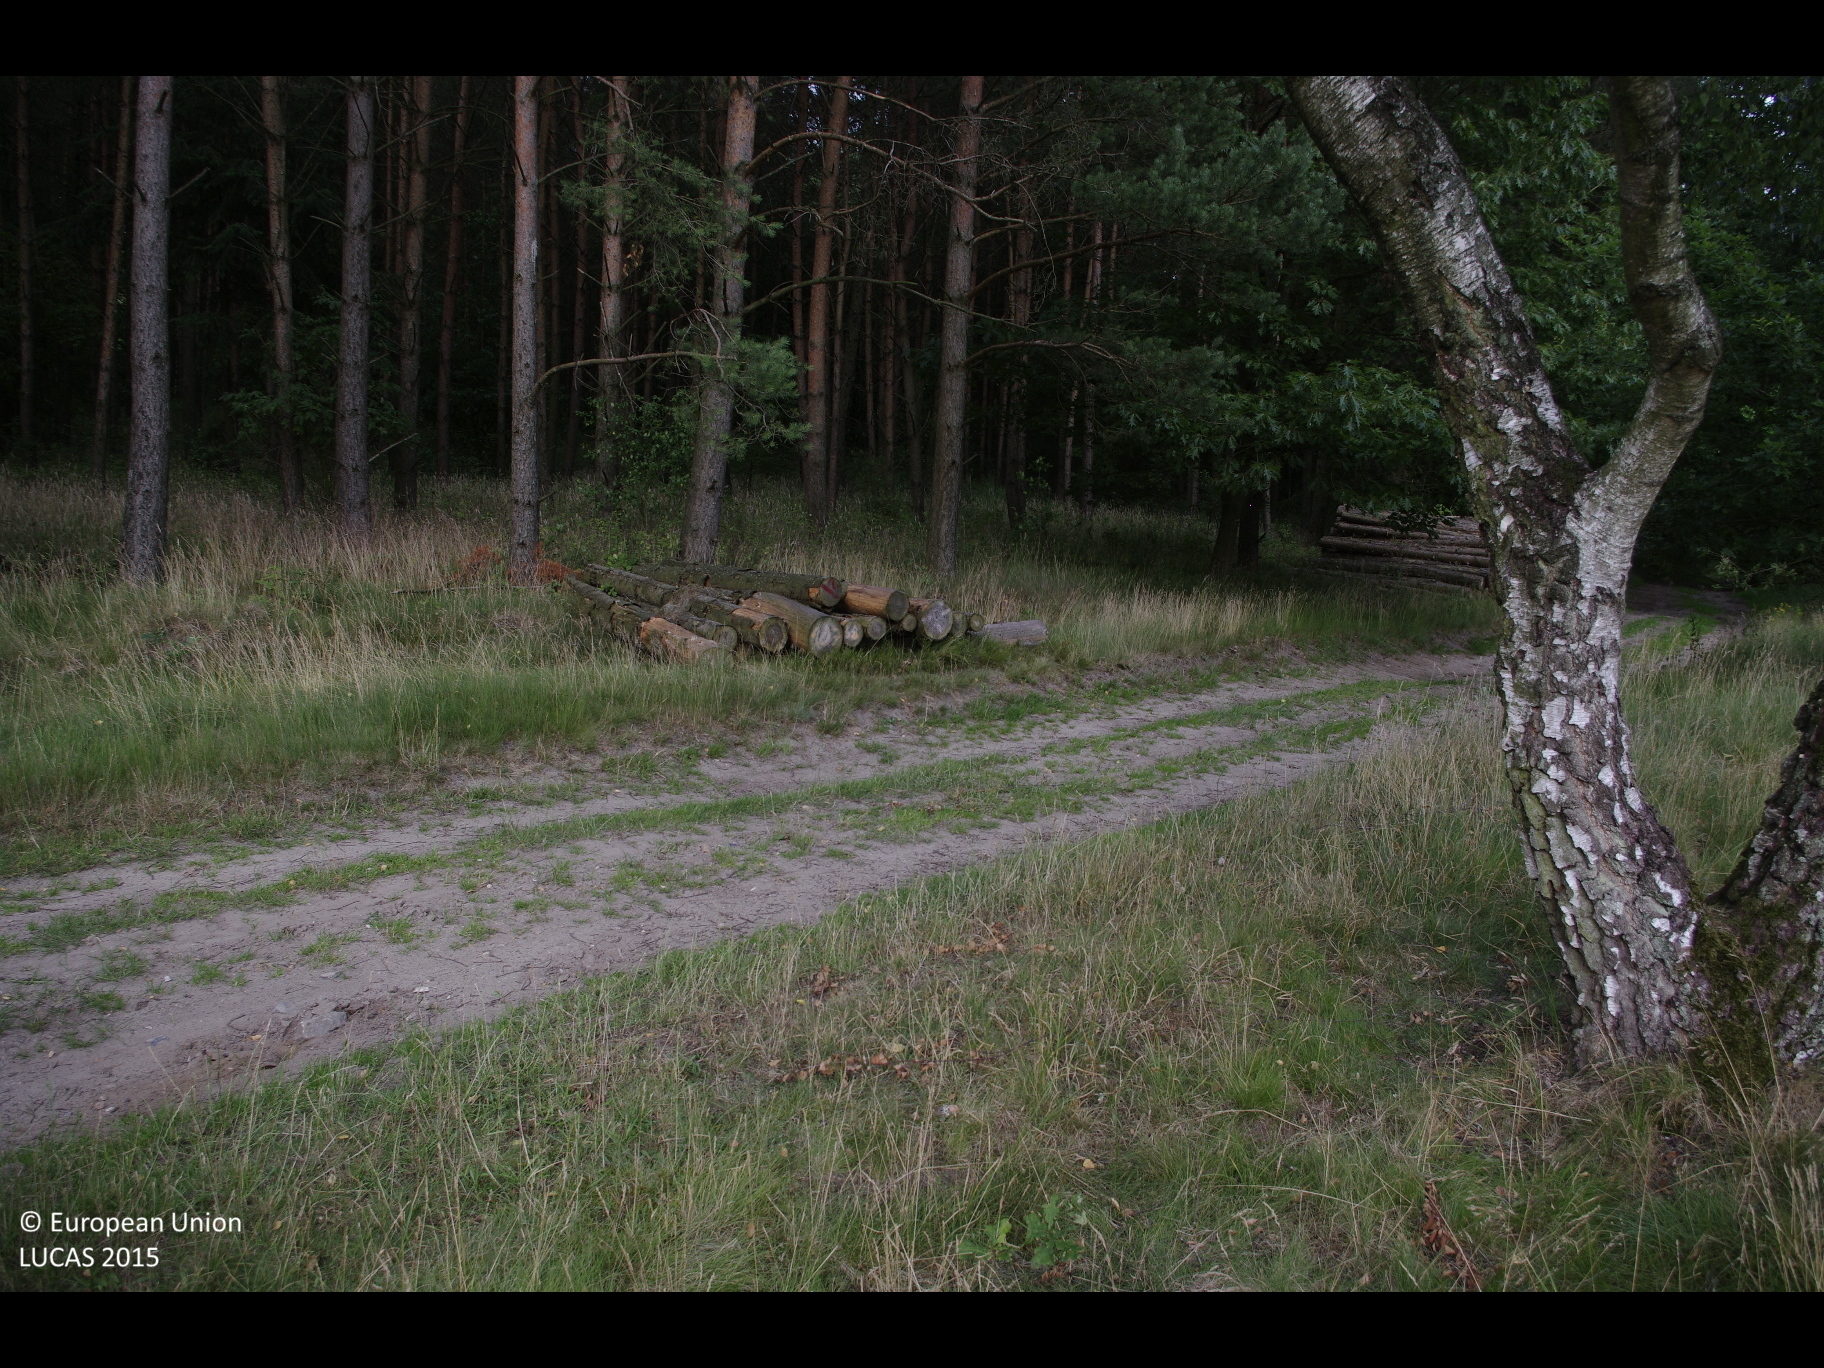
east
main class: Grassland
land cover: Grassland without tree/shrub cover
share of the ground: > 75 %
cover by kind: herbaceous plants 100 %
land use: Agriculture (excluding fallow land and kitchen gardens)
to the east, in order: Grassland without tree/shrub cover; Pine dominated coniferous woodland; Pine dominated mixed woodland; Fences; Shruby margins; Tracks
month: July
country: DE
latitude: 53.9411
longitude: 9.9239
